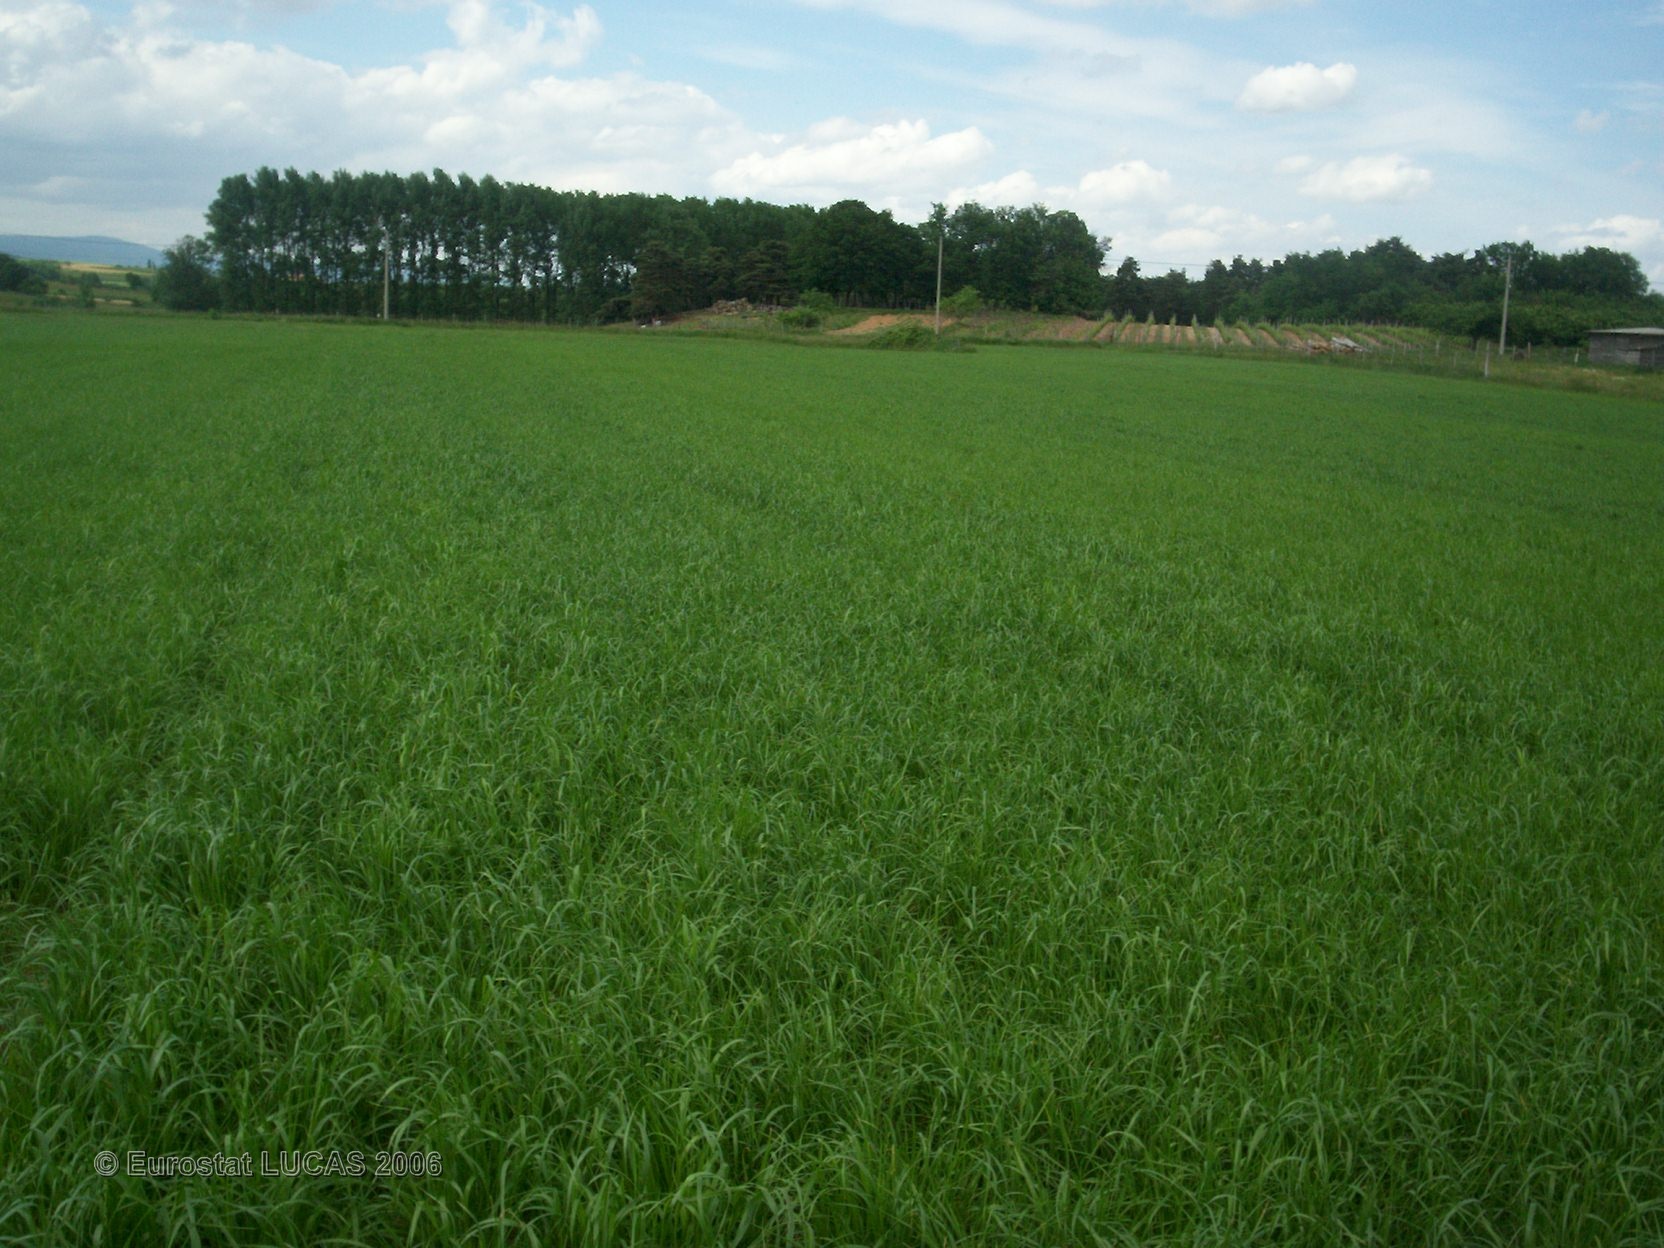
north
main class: Grassland
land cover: Grassland without tree/shrub cover
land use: Agriculture (excluding fallow land and kitchen gardens)
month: May
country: FR
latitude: 45.2663
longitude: 4.7665
